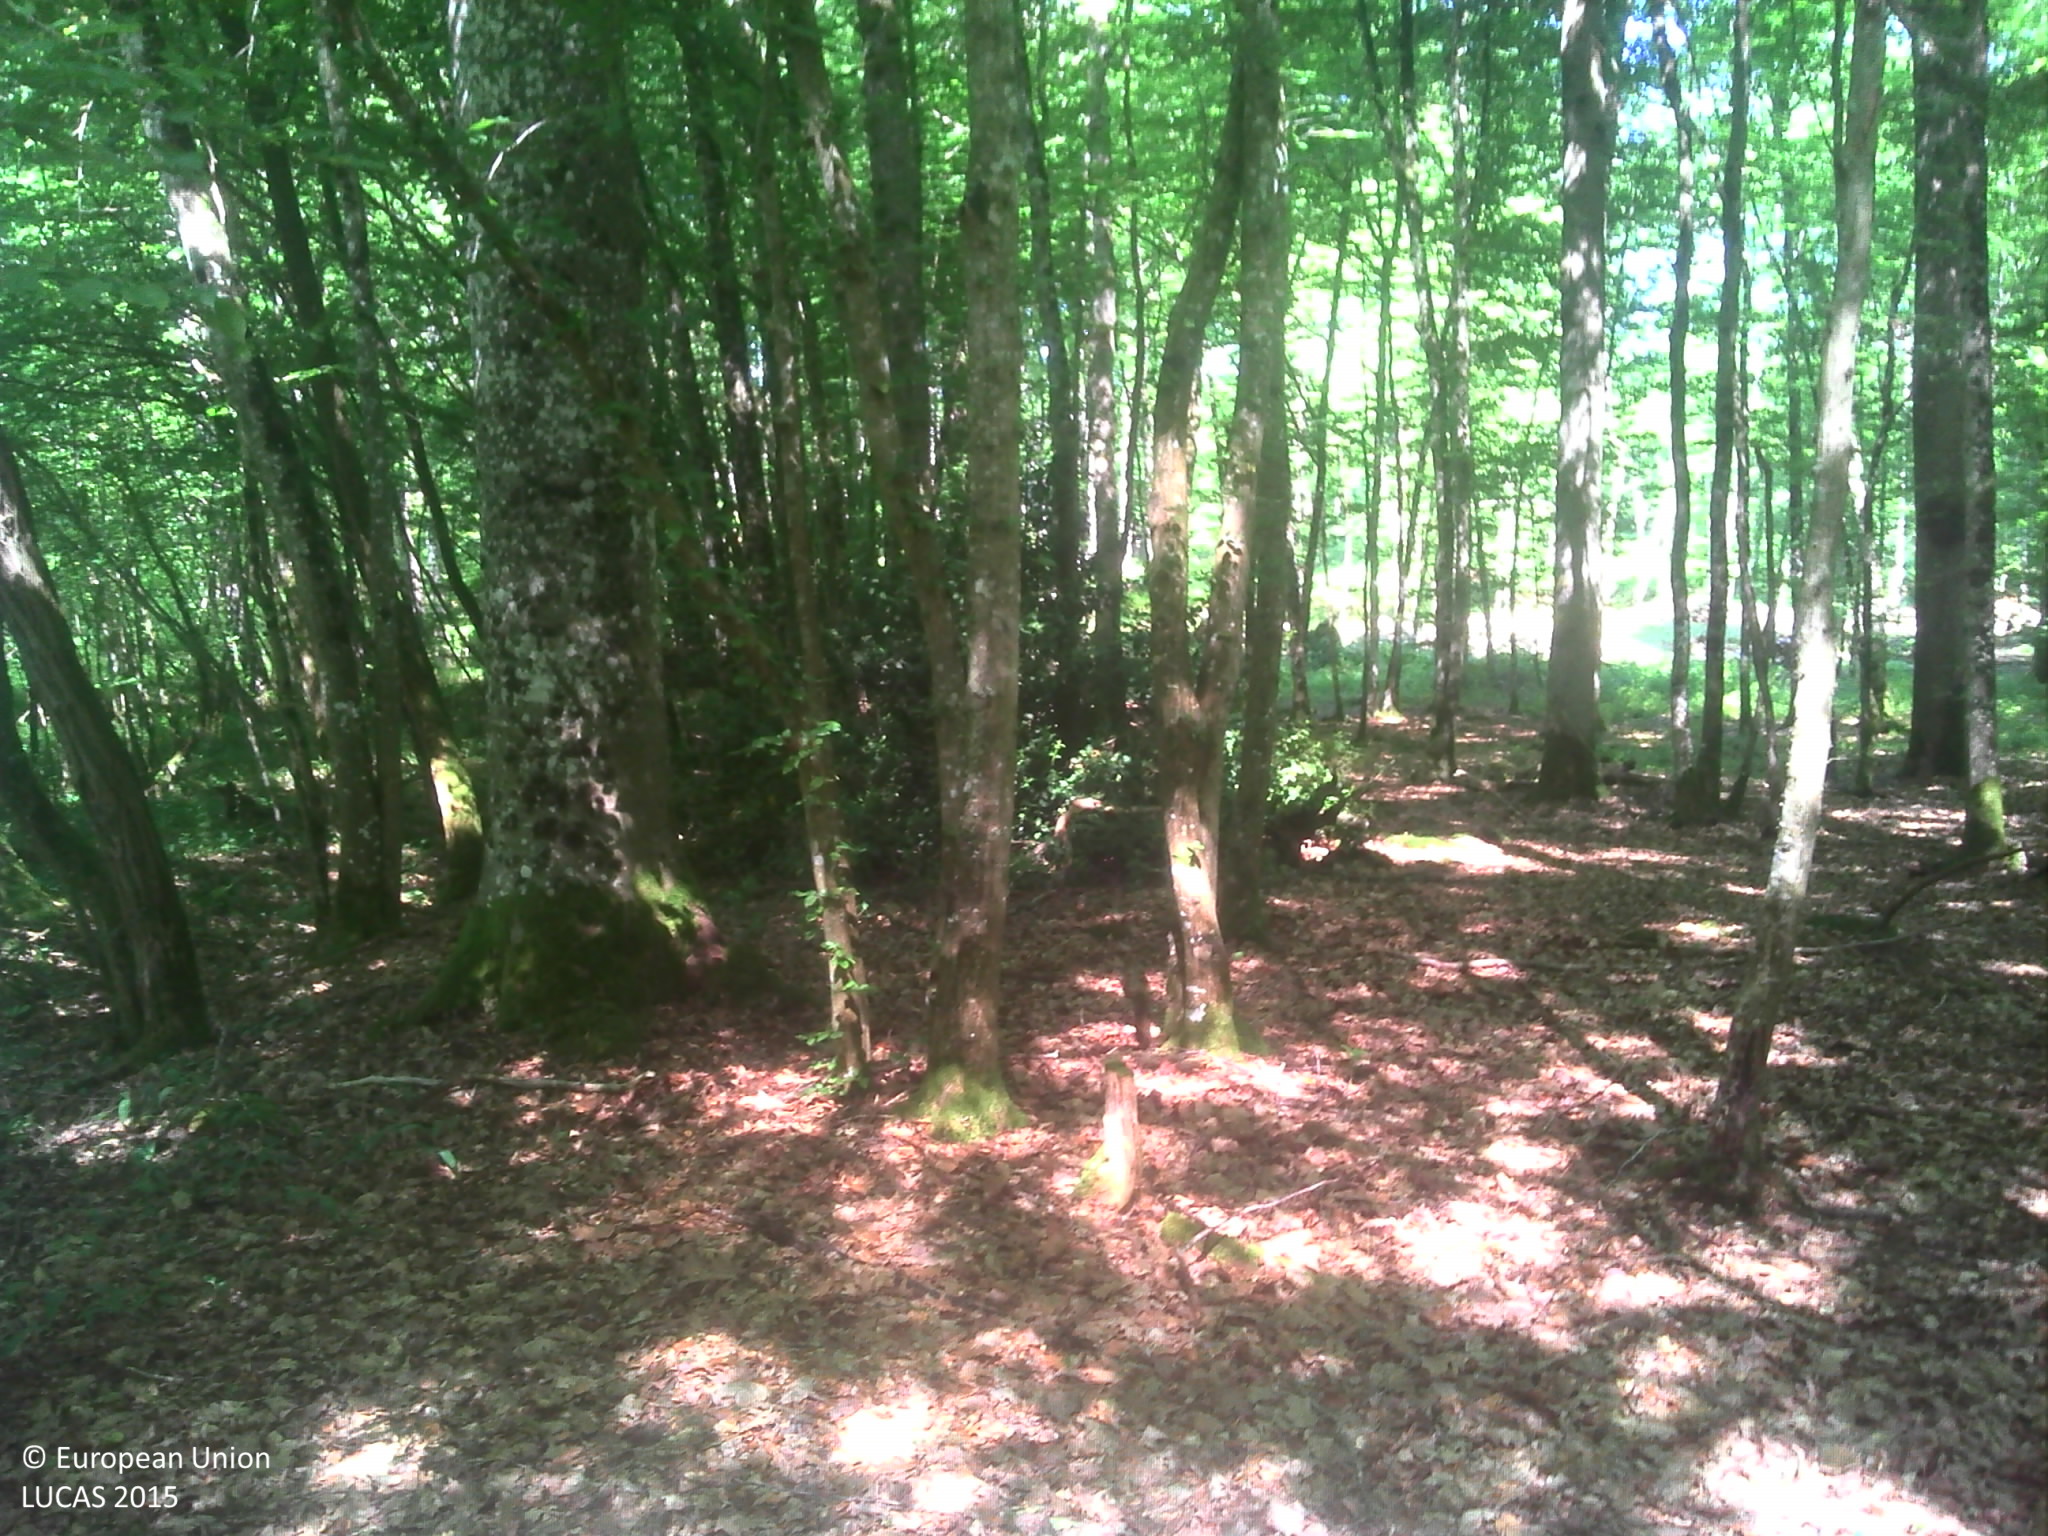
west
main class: Woodland
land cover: Broadleaved woodland
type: acidophilous oak and oak-birch forest
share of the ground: > 75 %
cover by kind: broadleaved forest trees 85 %, herbaceous plants 10 %, coniferous forest trees 5 %
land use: Forestry
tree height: > 5 m
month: June
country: FR
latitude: 48.4034
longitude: 4.7163
